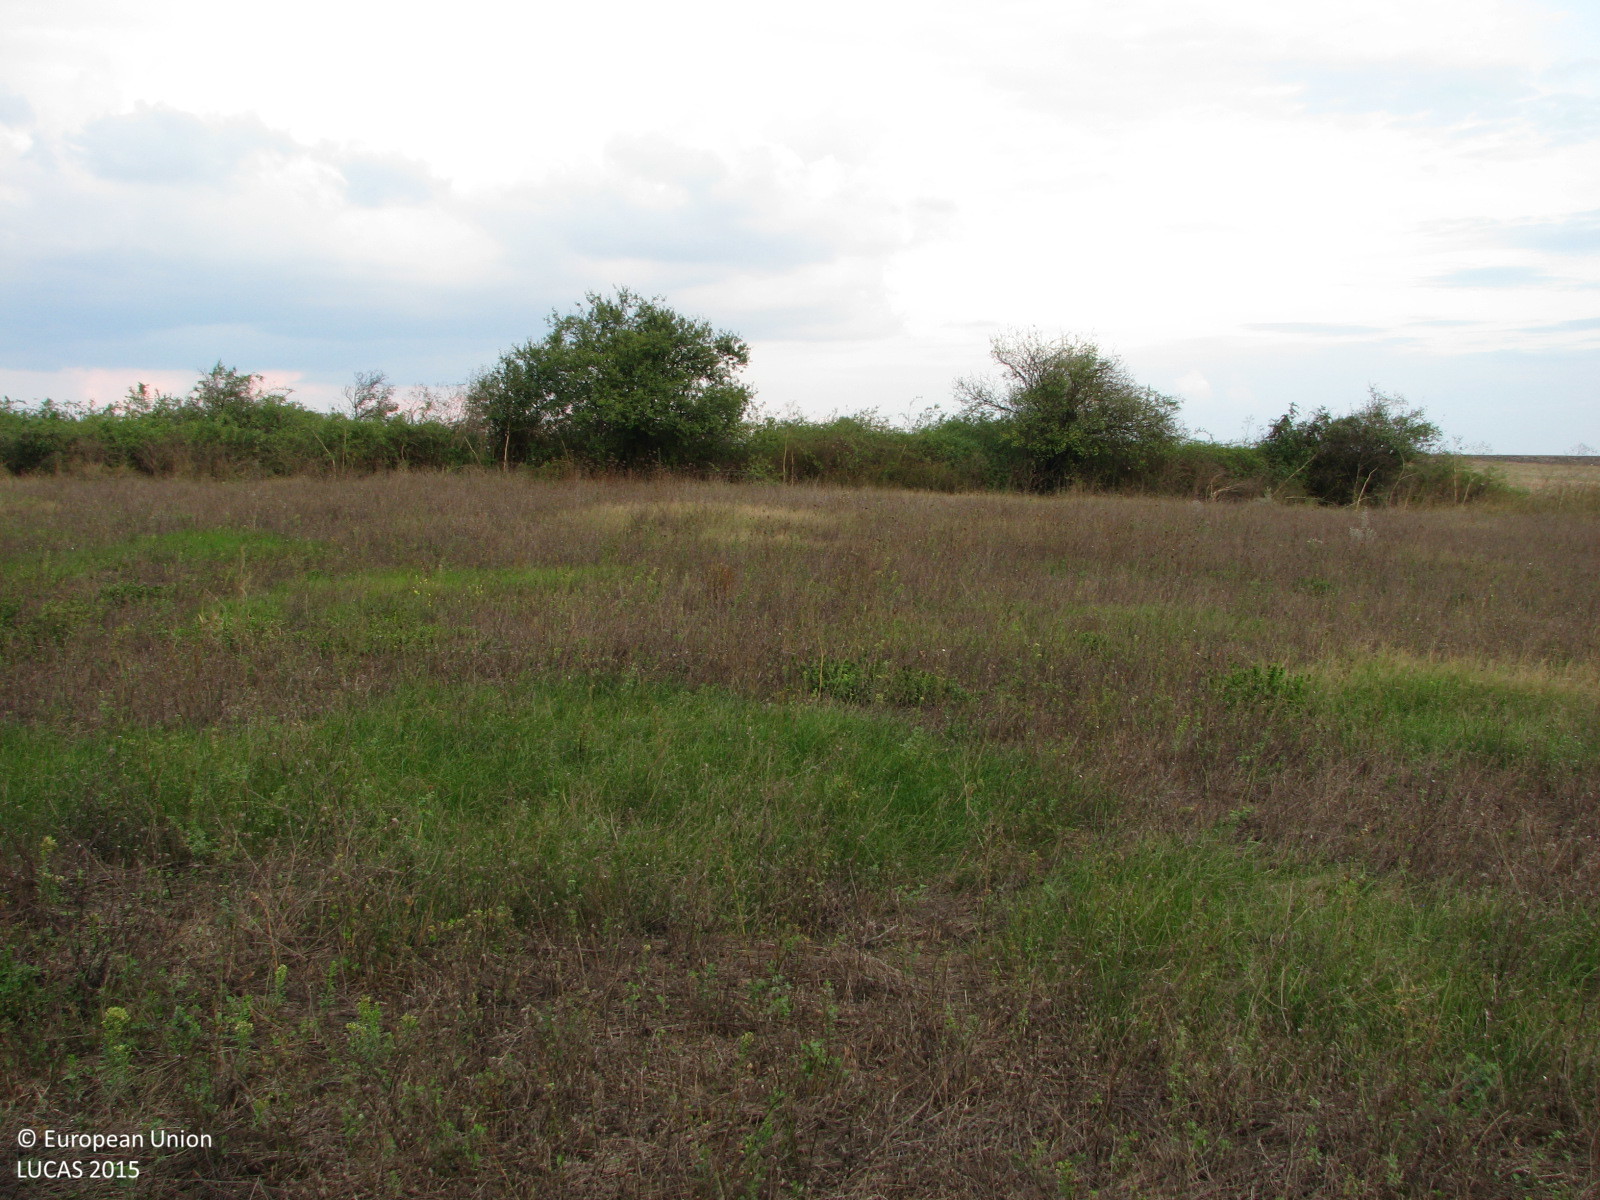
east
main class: Cropland
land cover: Lucerne
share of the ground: 25 - 50 %
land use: Agriculture (excluding fallow land and kitchen gardens)
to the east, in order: Lucerne; Fences; Abandoned hedges; Tracks; Other bare soil; Tracks; Common wheat; Abandoned hedges; Other bare soil
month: October
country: BG
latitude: 42.2797
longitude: 26.5207
